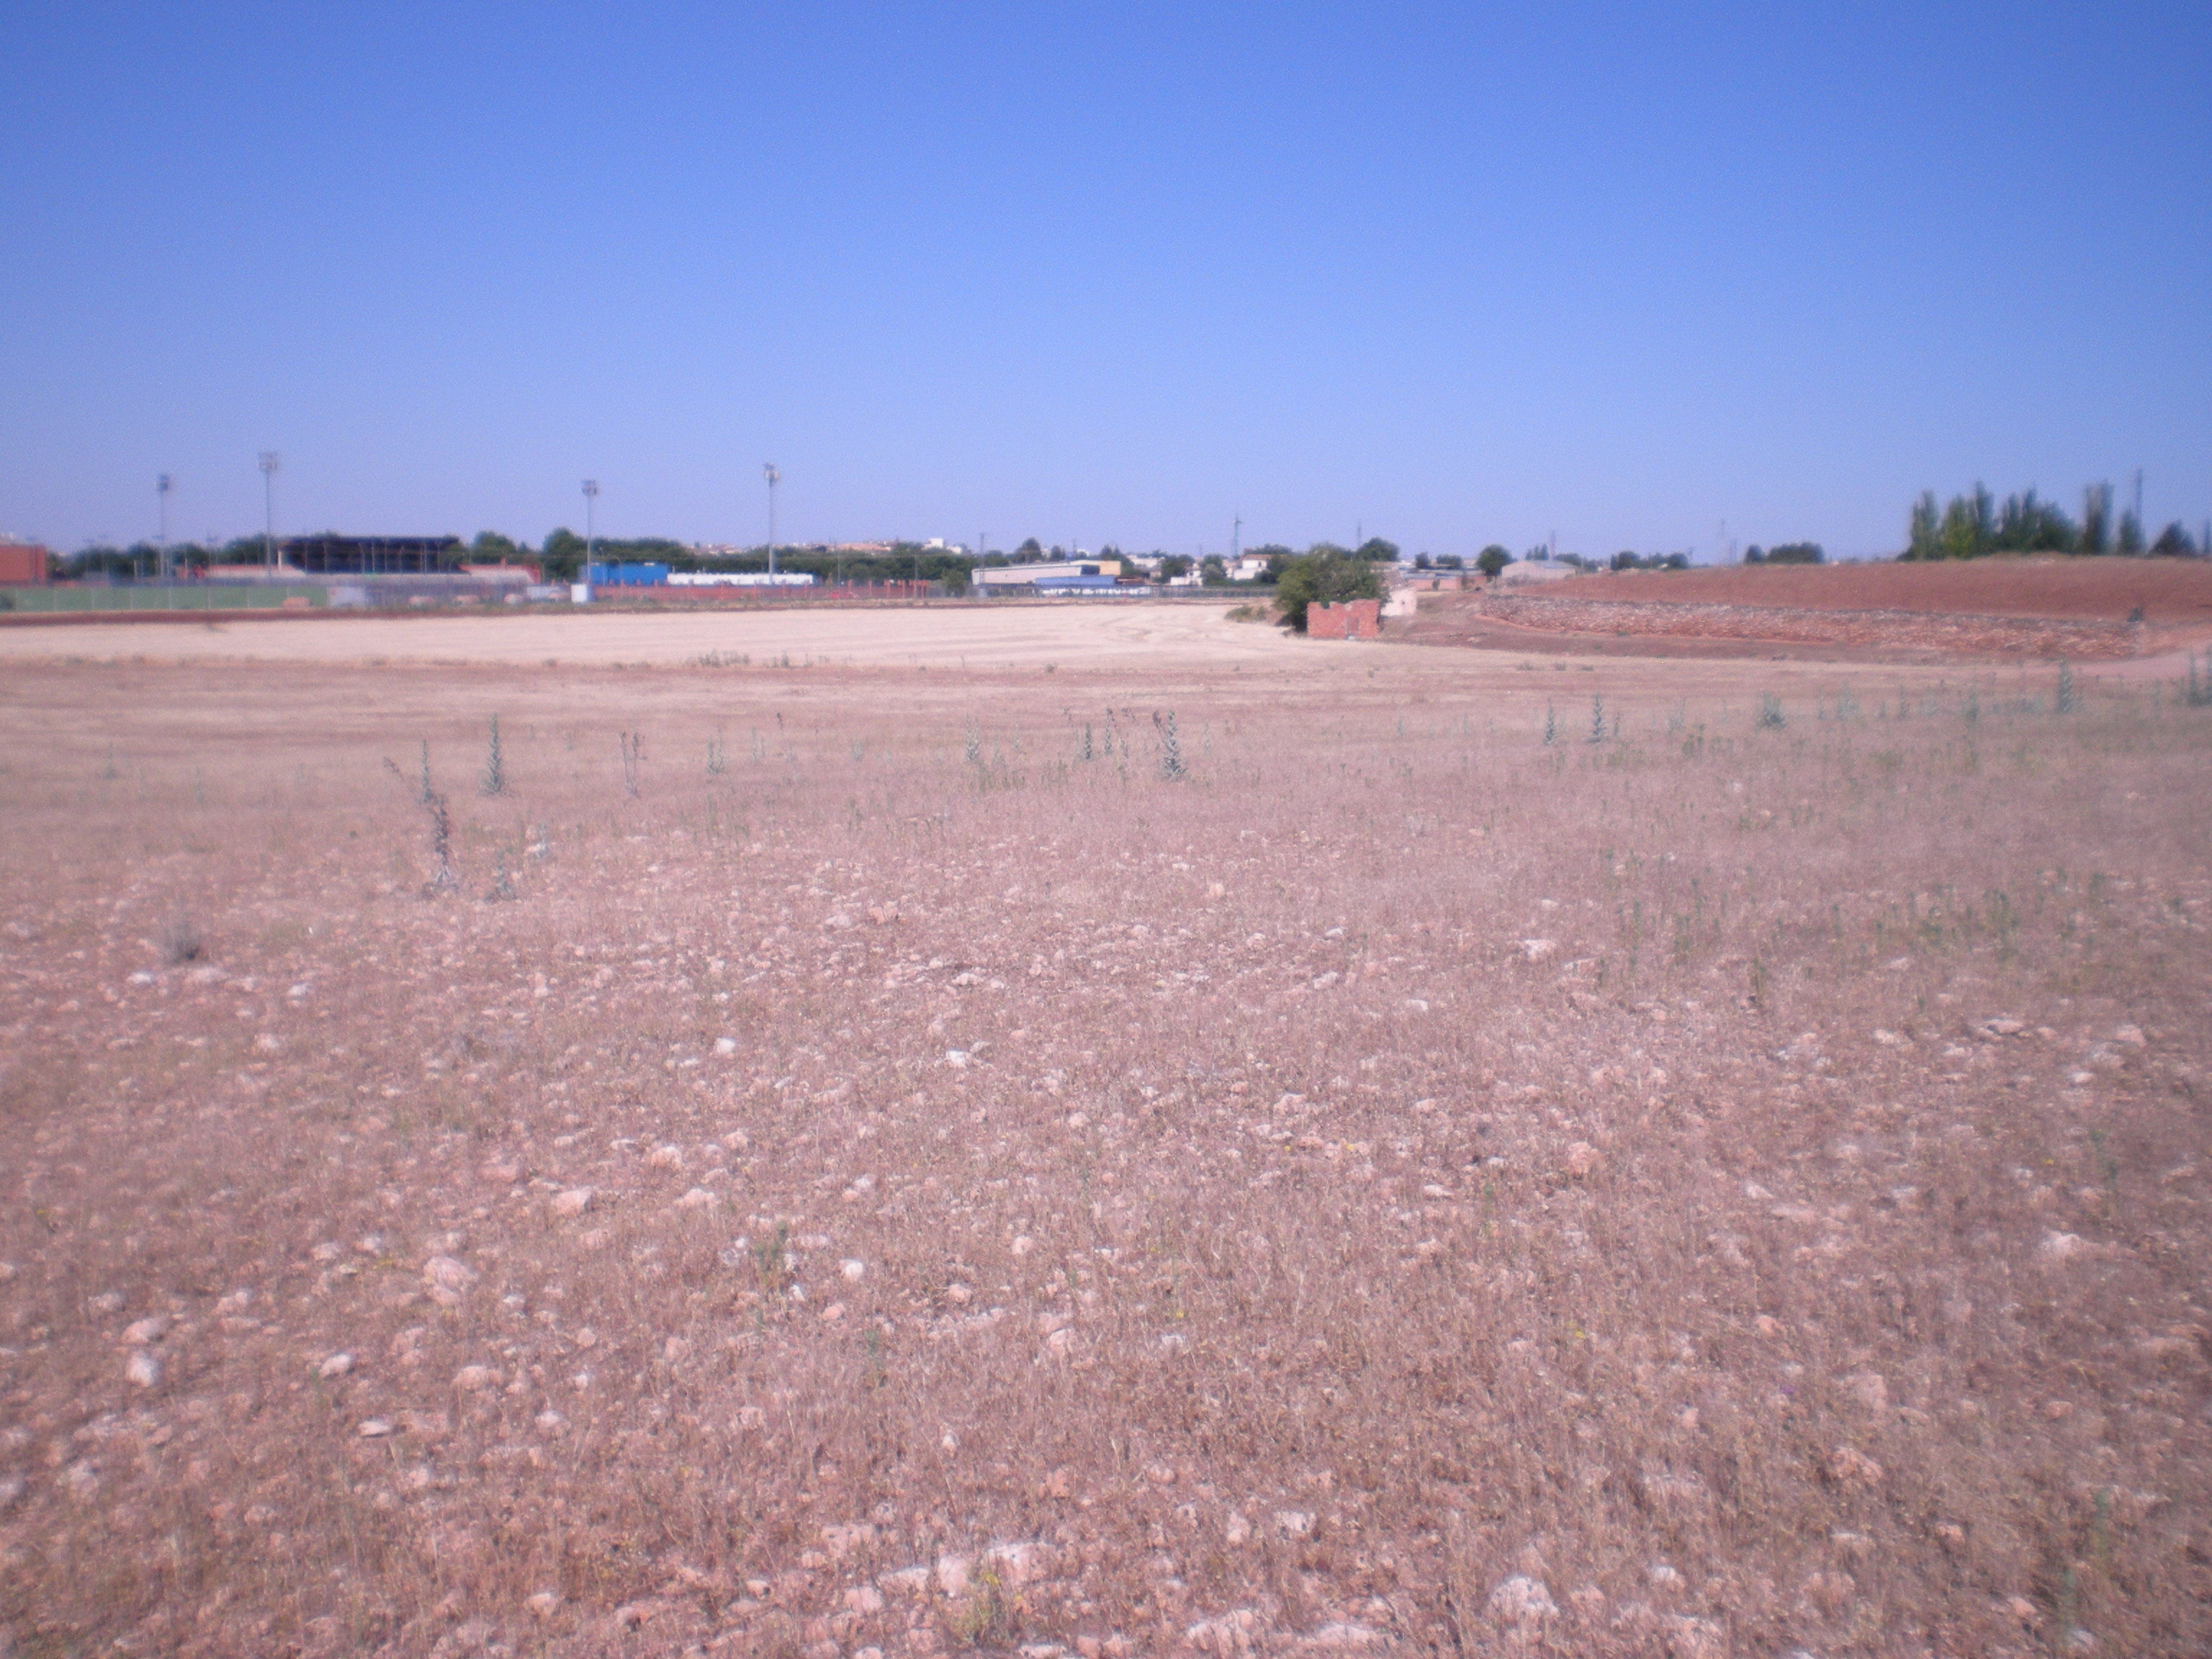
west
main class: Grassland
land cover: Spontaneously vegetated surfaces
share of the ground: 10 - 25 %
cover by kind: unconsolidated bare surface 90 %, herbaceous plants 10 %
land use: Agriculture (excluding fallow land and kitchen gardens)
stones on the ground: 10 - 25 %
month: May
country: ES
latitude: 39.0772
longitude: -3.6000
